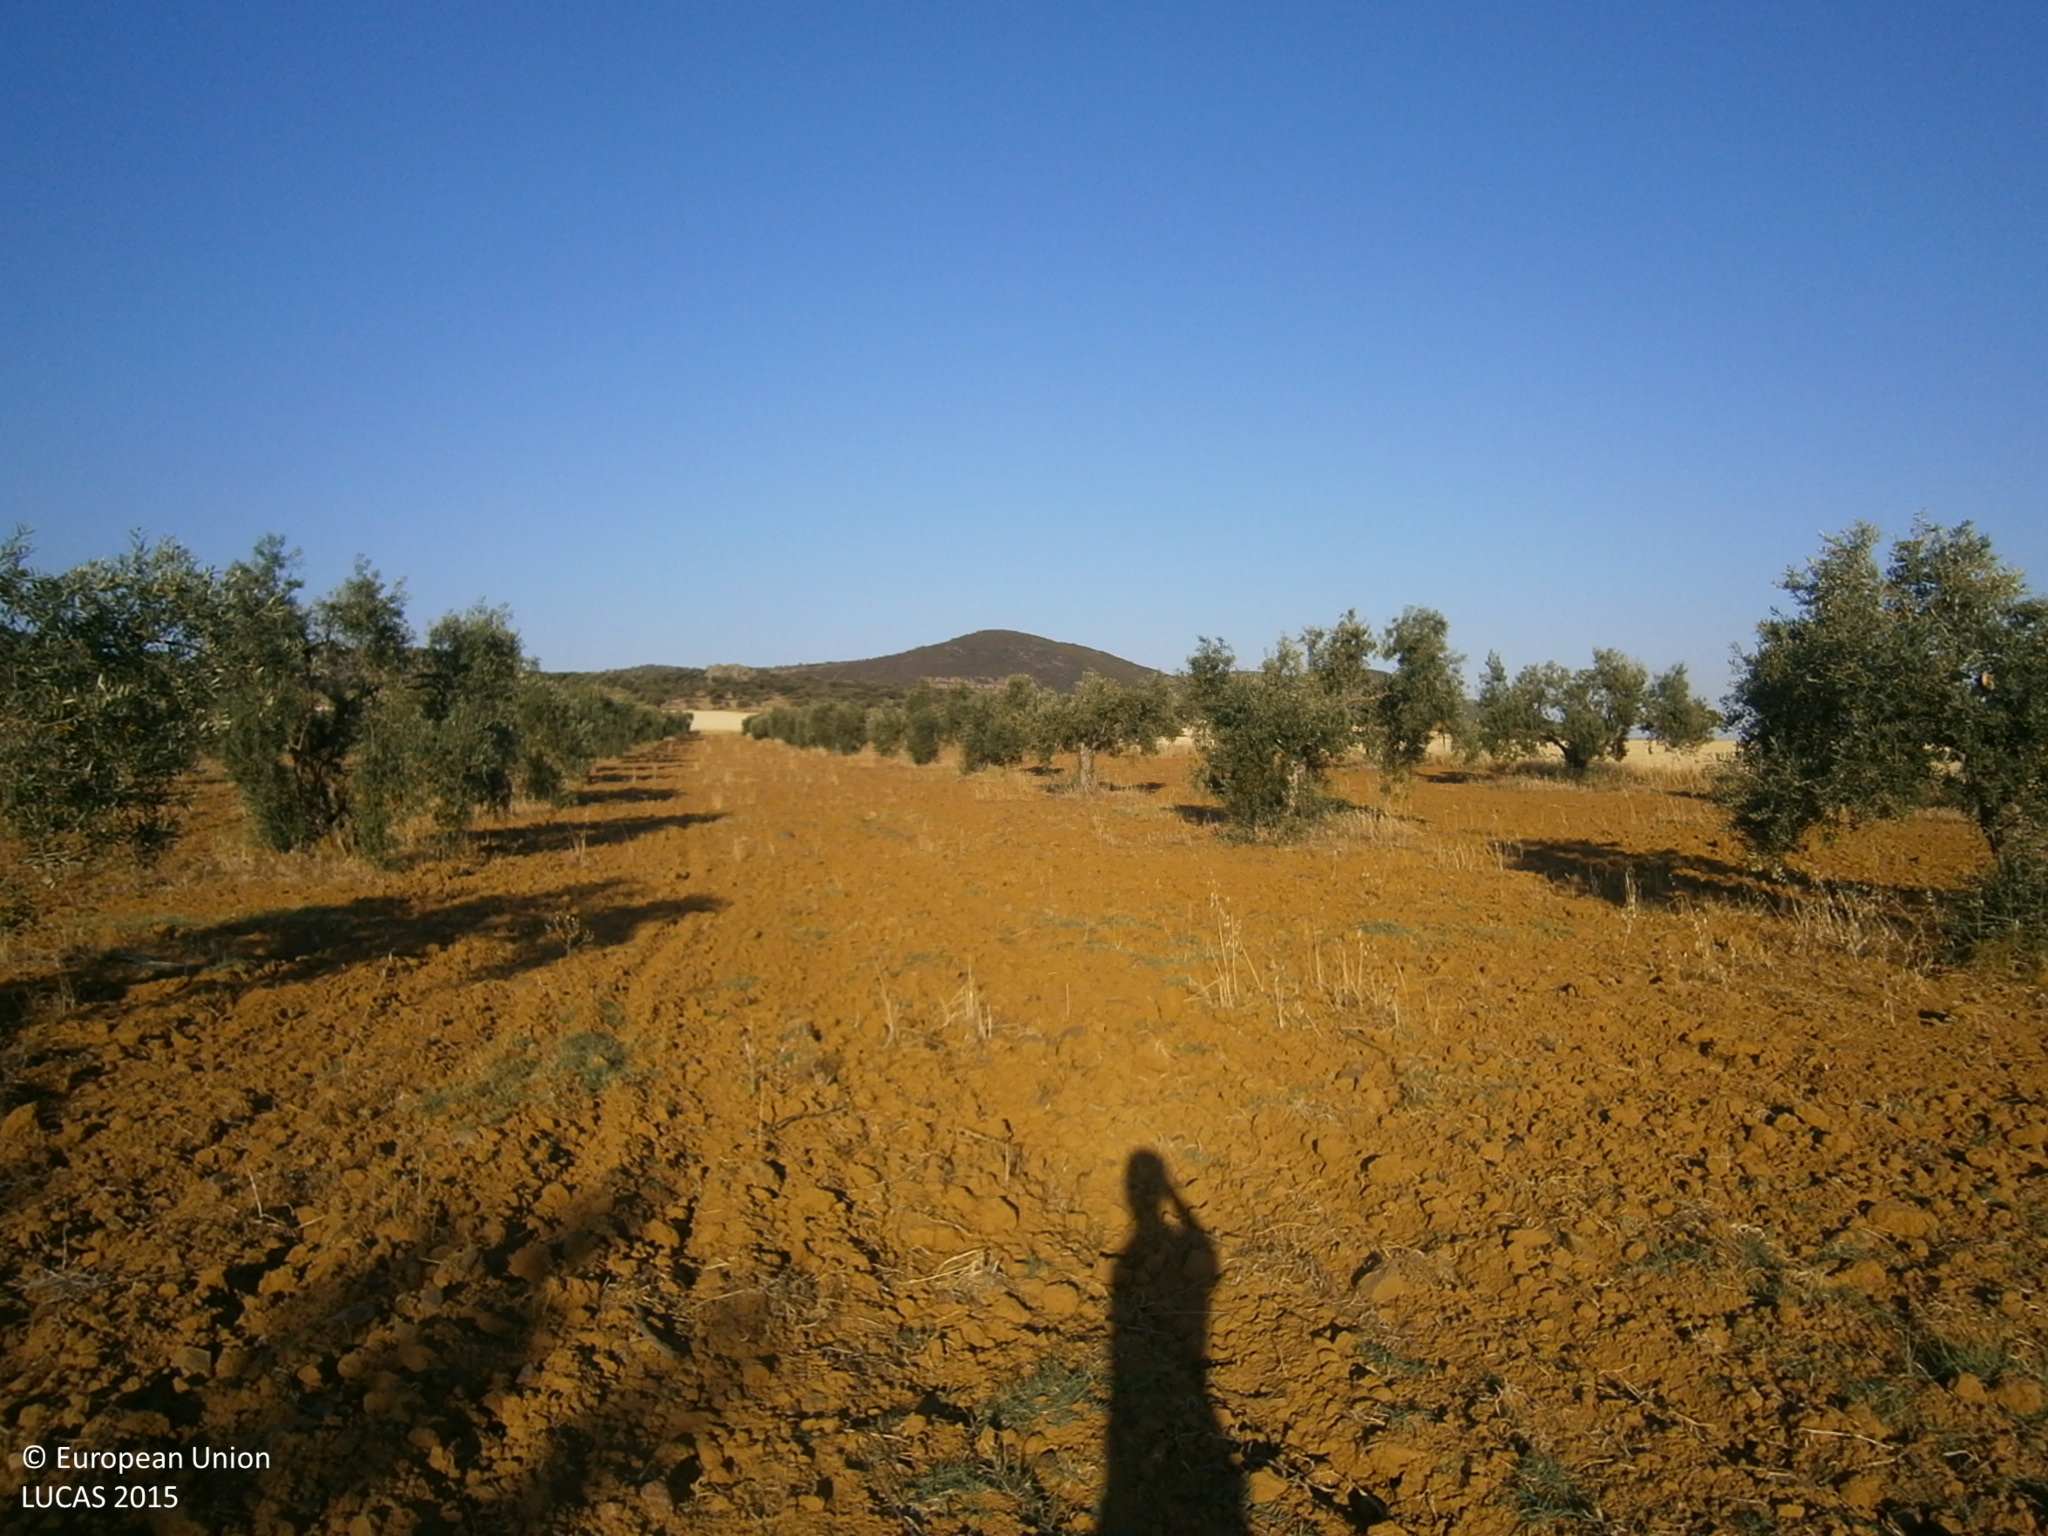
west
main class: Cropland
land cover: Olive groves
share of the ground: 10 - 25 %
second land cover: Other bare soil
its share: > 75 %
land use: Agriculture (excluding fallow land and kitchen gardens)
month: June
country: ES
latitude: 38.5841
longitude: -6.5991
